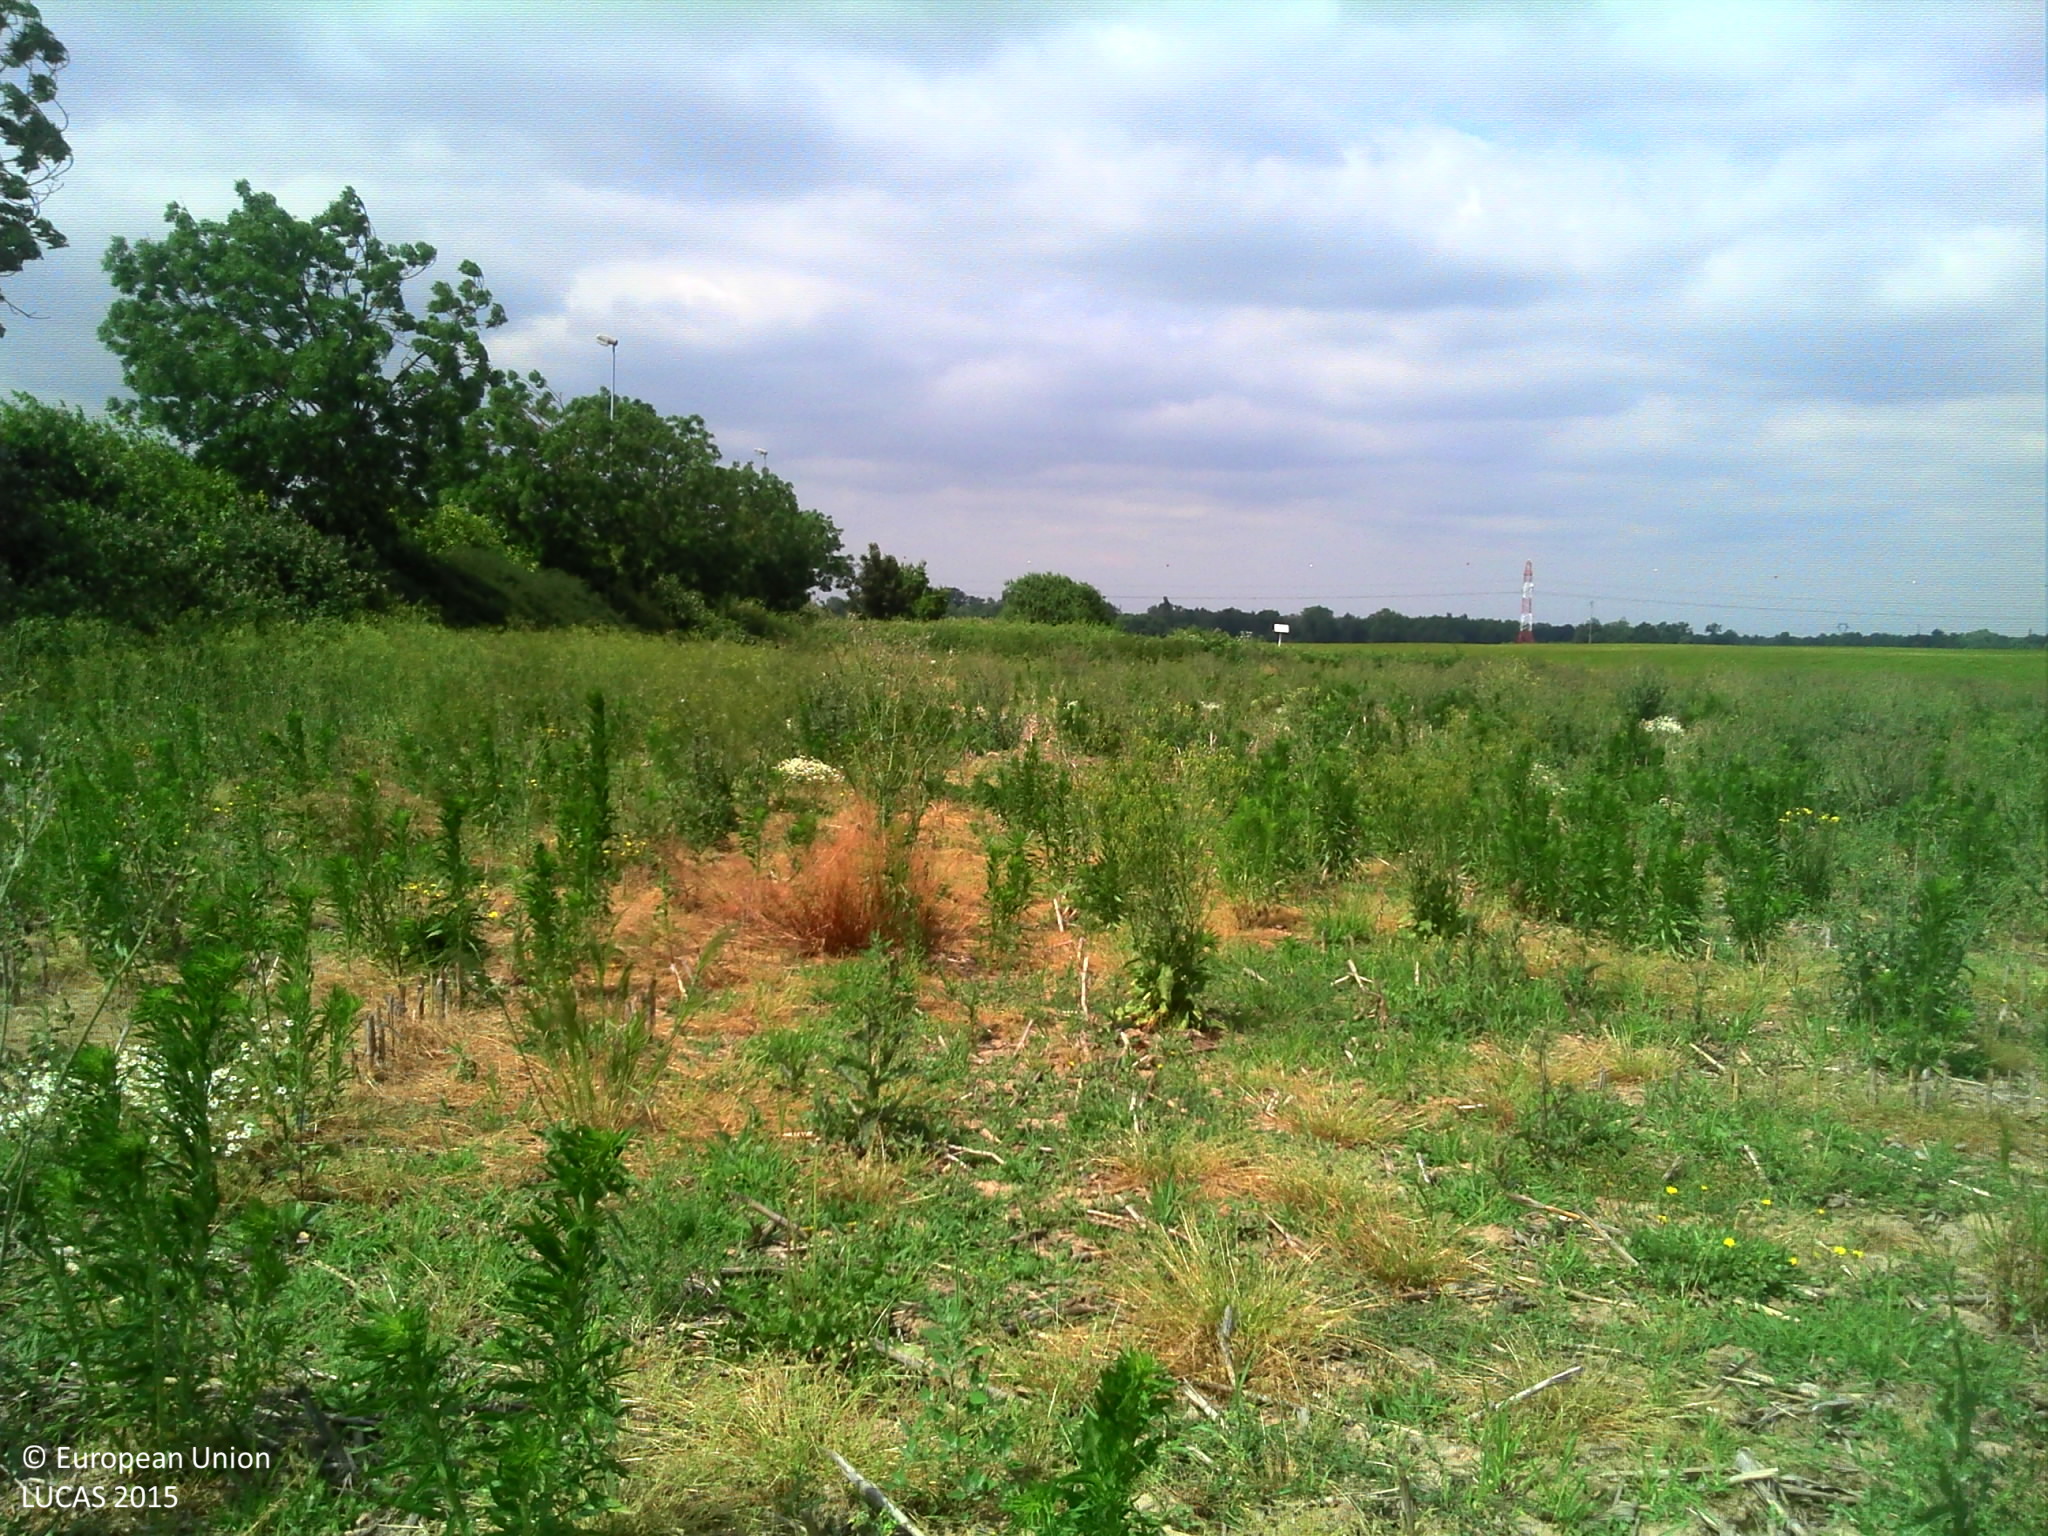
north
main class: Grassland
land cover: Spontaneously vegetated surfaces
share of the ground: > 75 %
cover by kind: herbaceous plants 100 %
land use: Fallow land
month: June
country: FR
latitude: 48.5587
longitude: 7.6568
